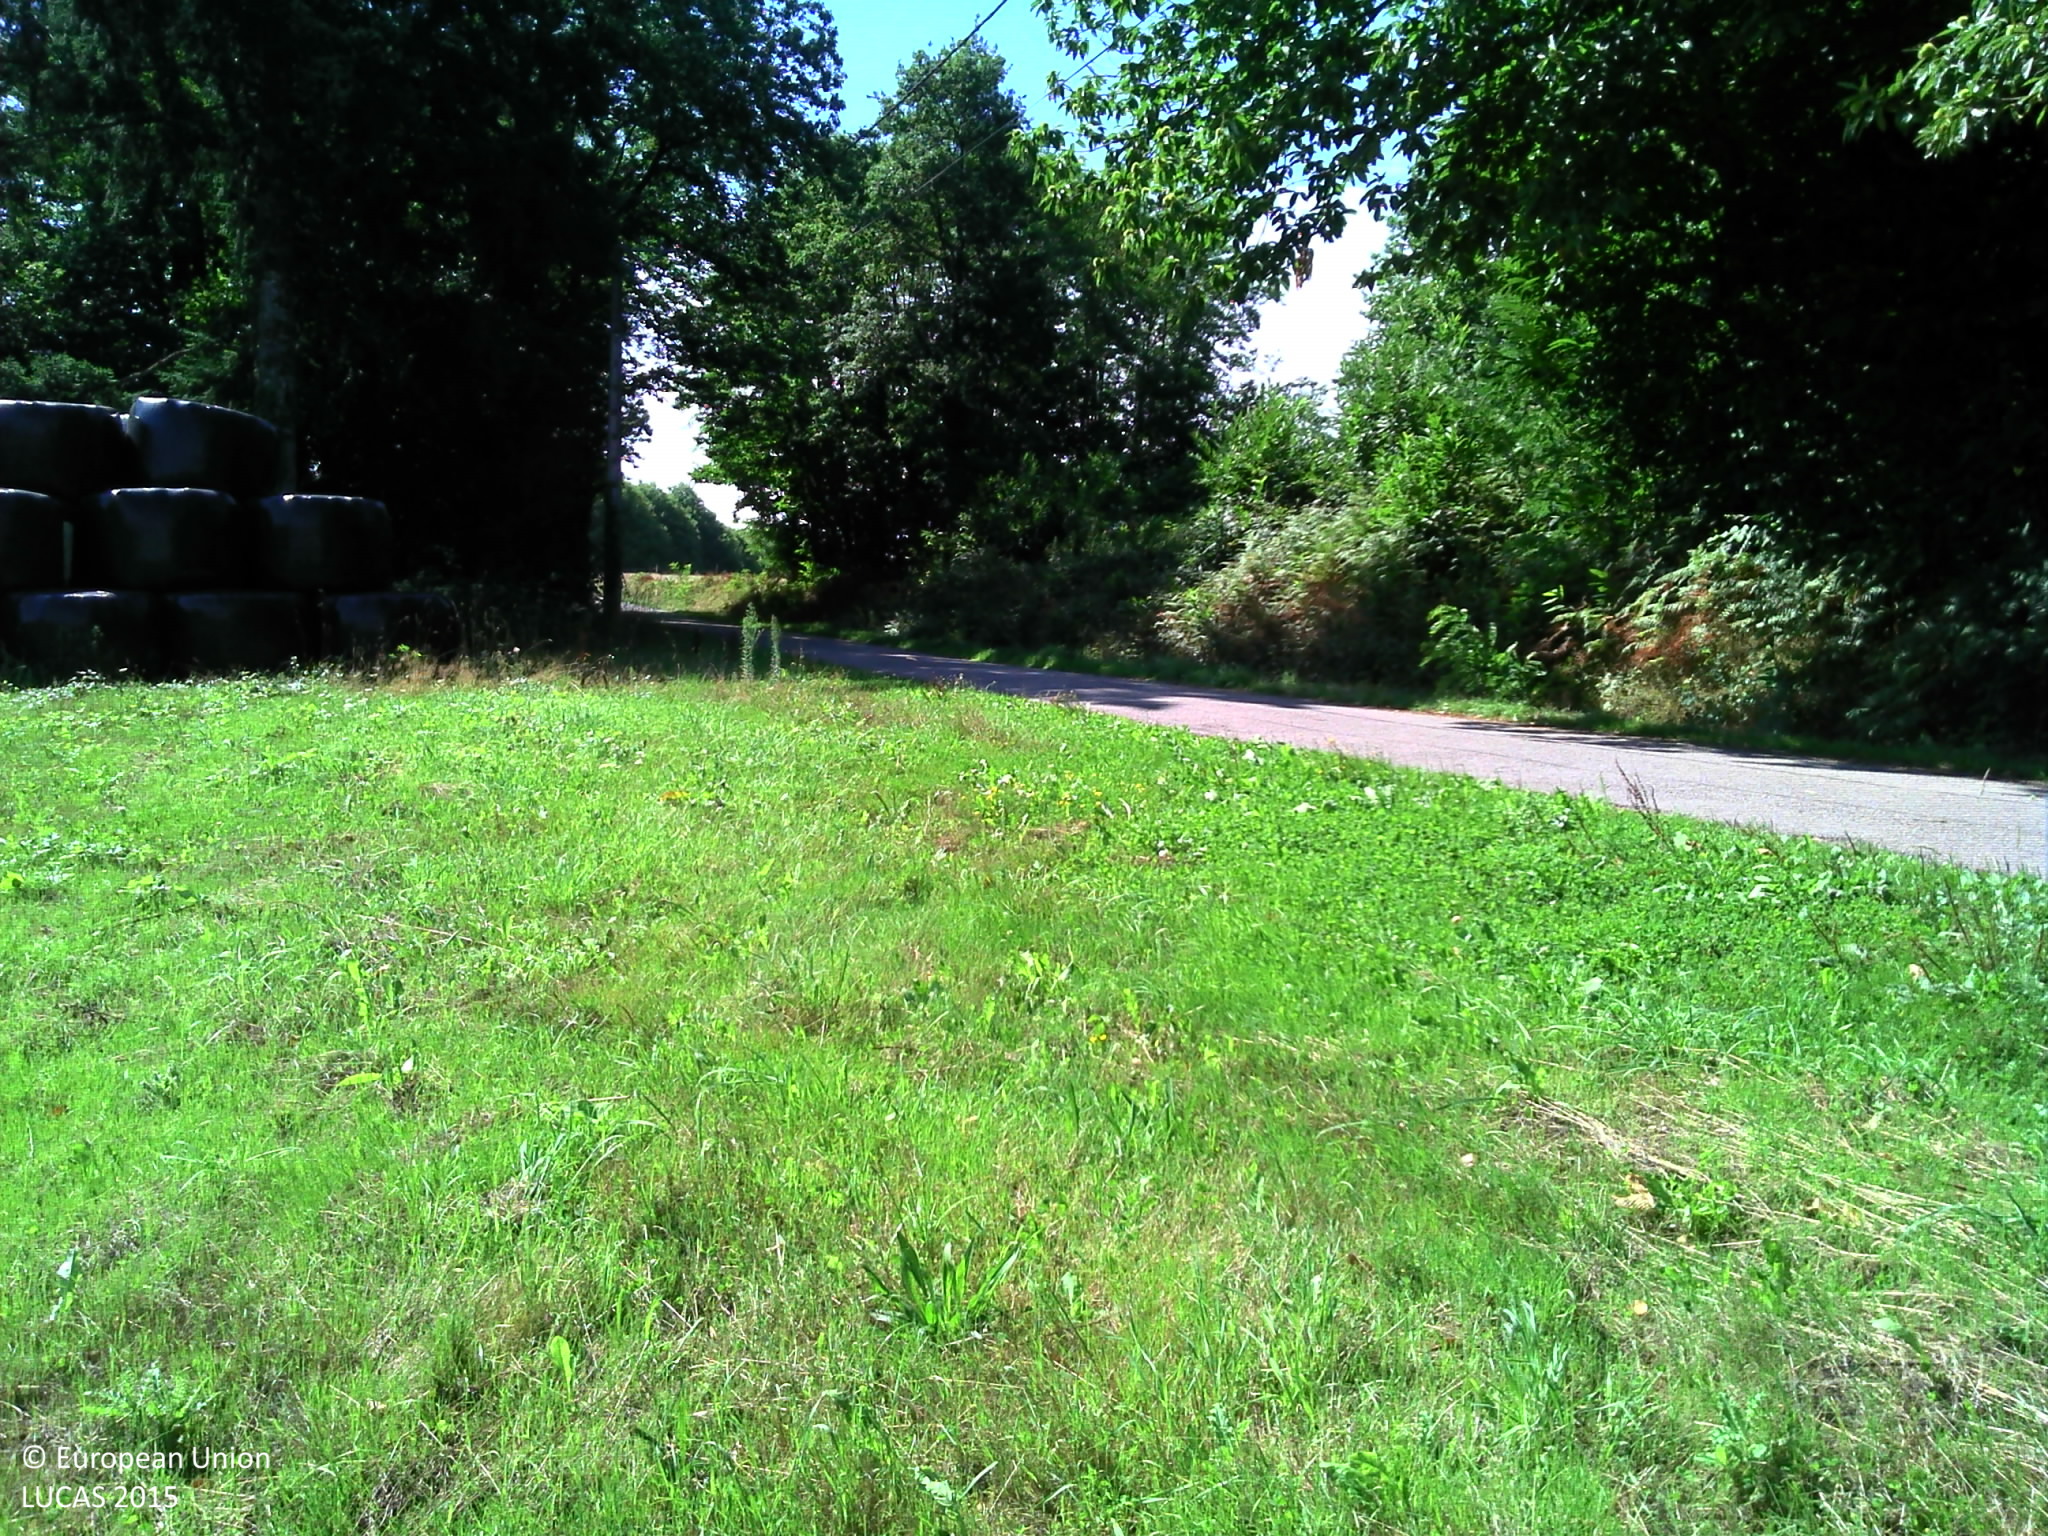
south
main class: Grassland
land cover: Spontaneously vegetated surfaces
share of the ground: > 75 %
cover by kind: herbaceous plants 95 %
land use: Agriculture (excluding fallow land and kitchen gardens)
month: August
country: FR
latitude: 45.6029
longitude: 1.3638
